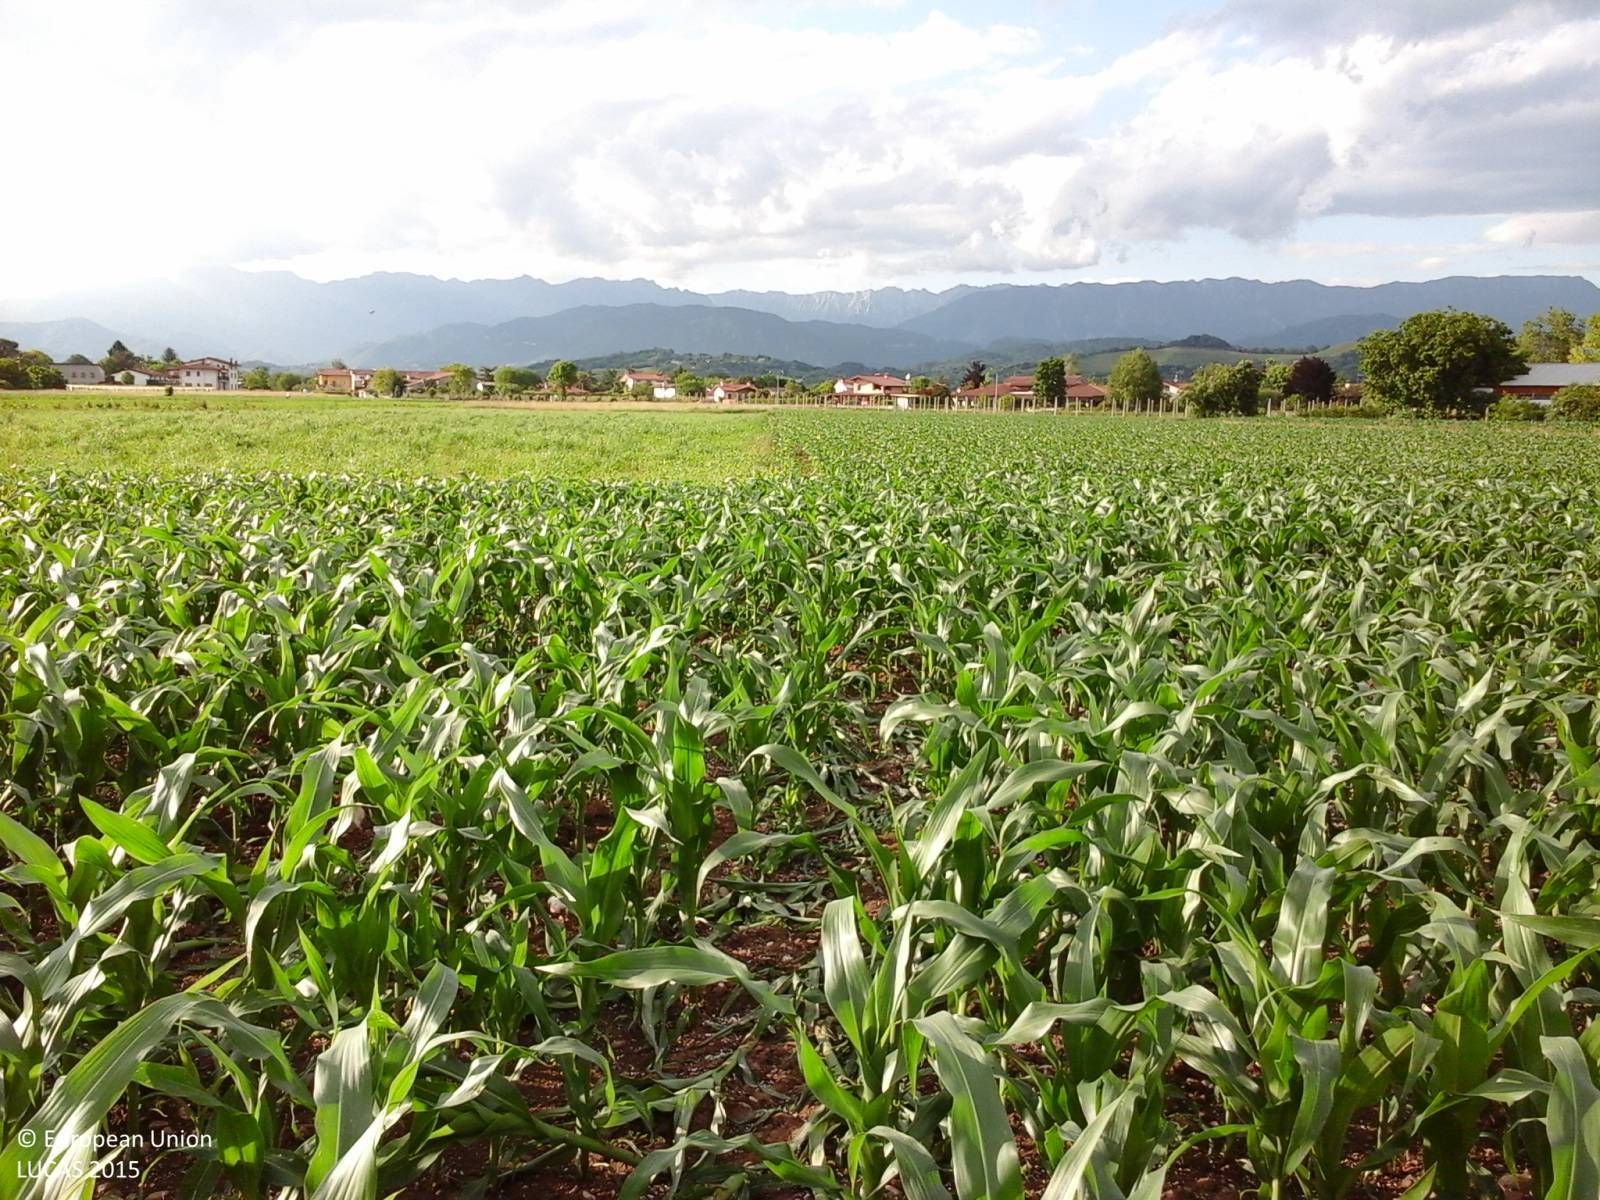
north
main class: Cropland
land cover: Maize
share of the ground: > 75 %
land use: Agriculture (excluding fallow land and kitchen gardens)
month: May
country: IT
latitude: 46.1390
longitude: 13.2716
